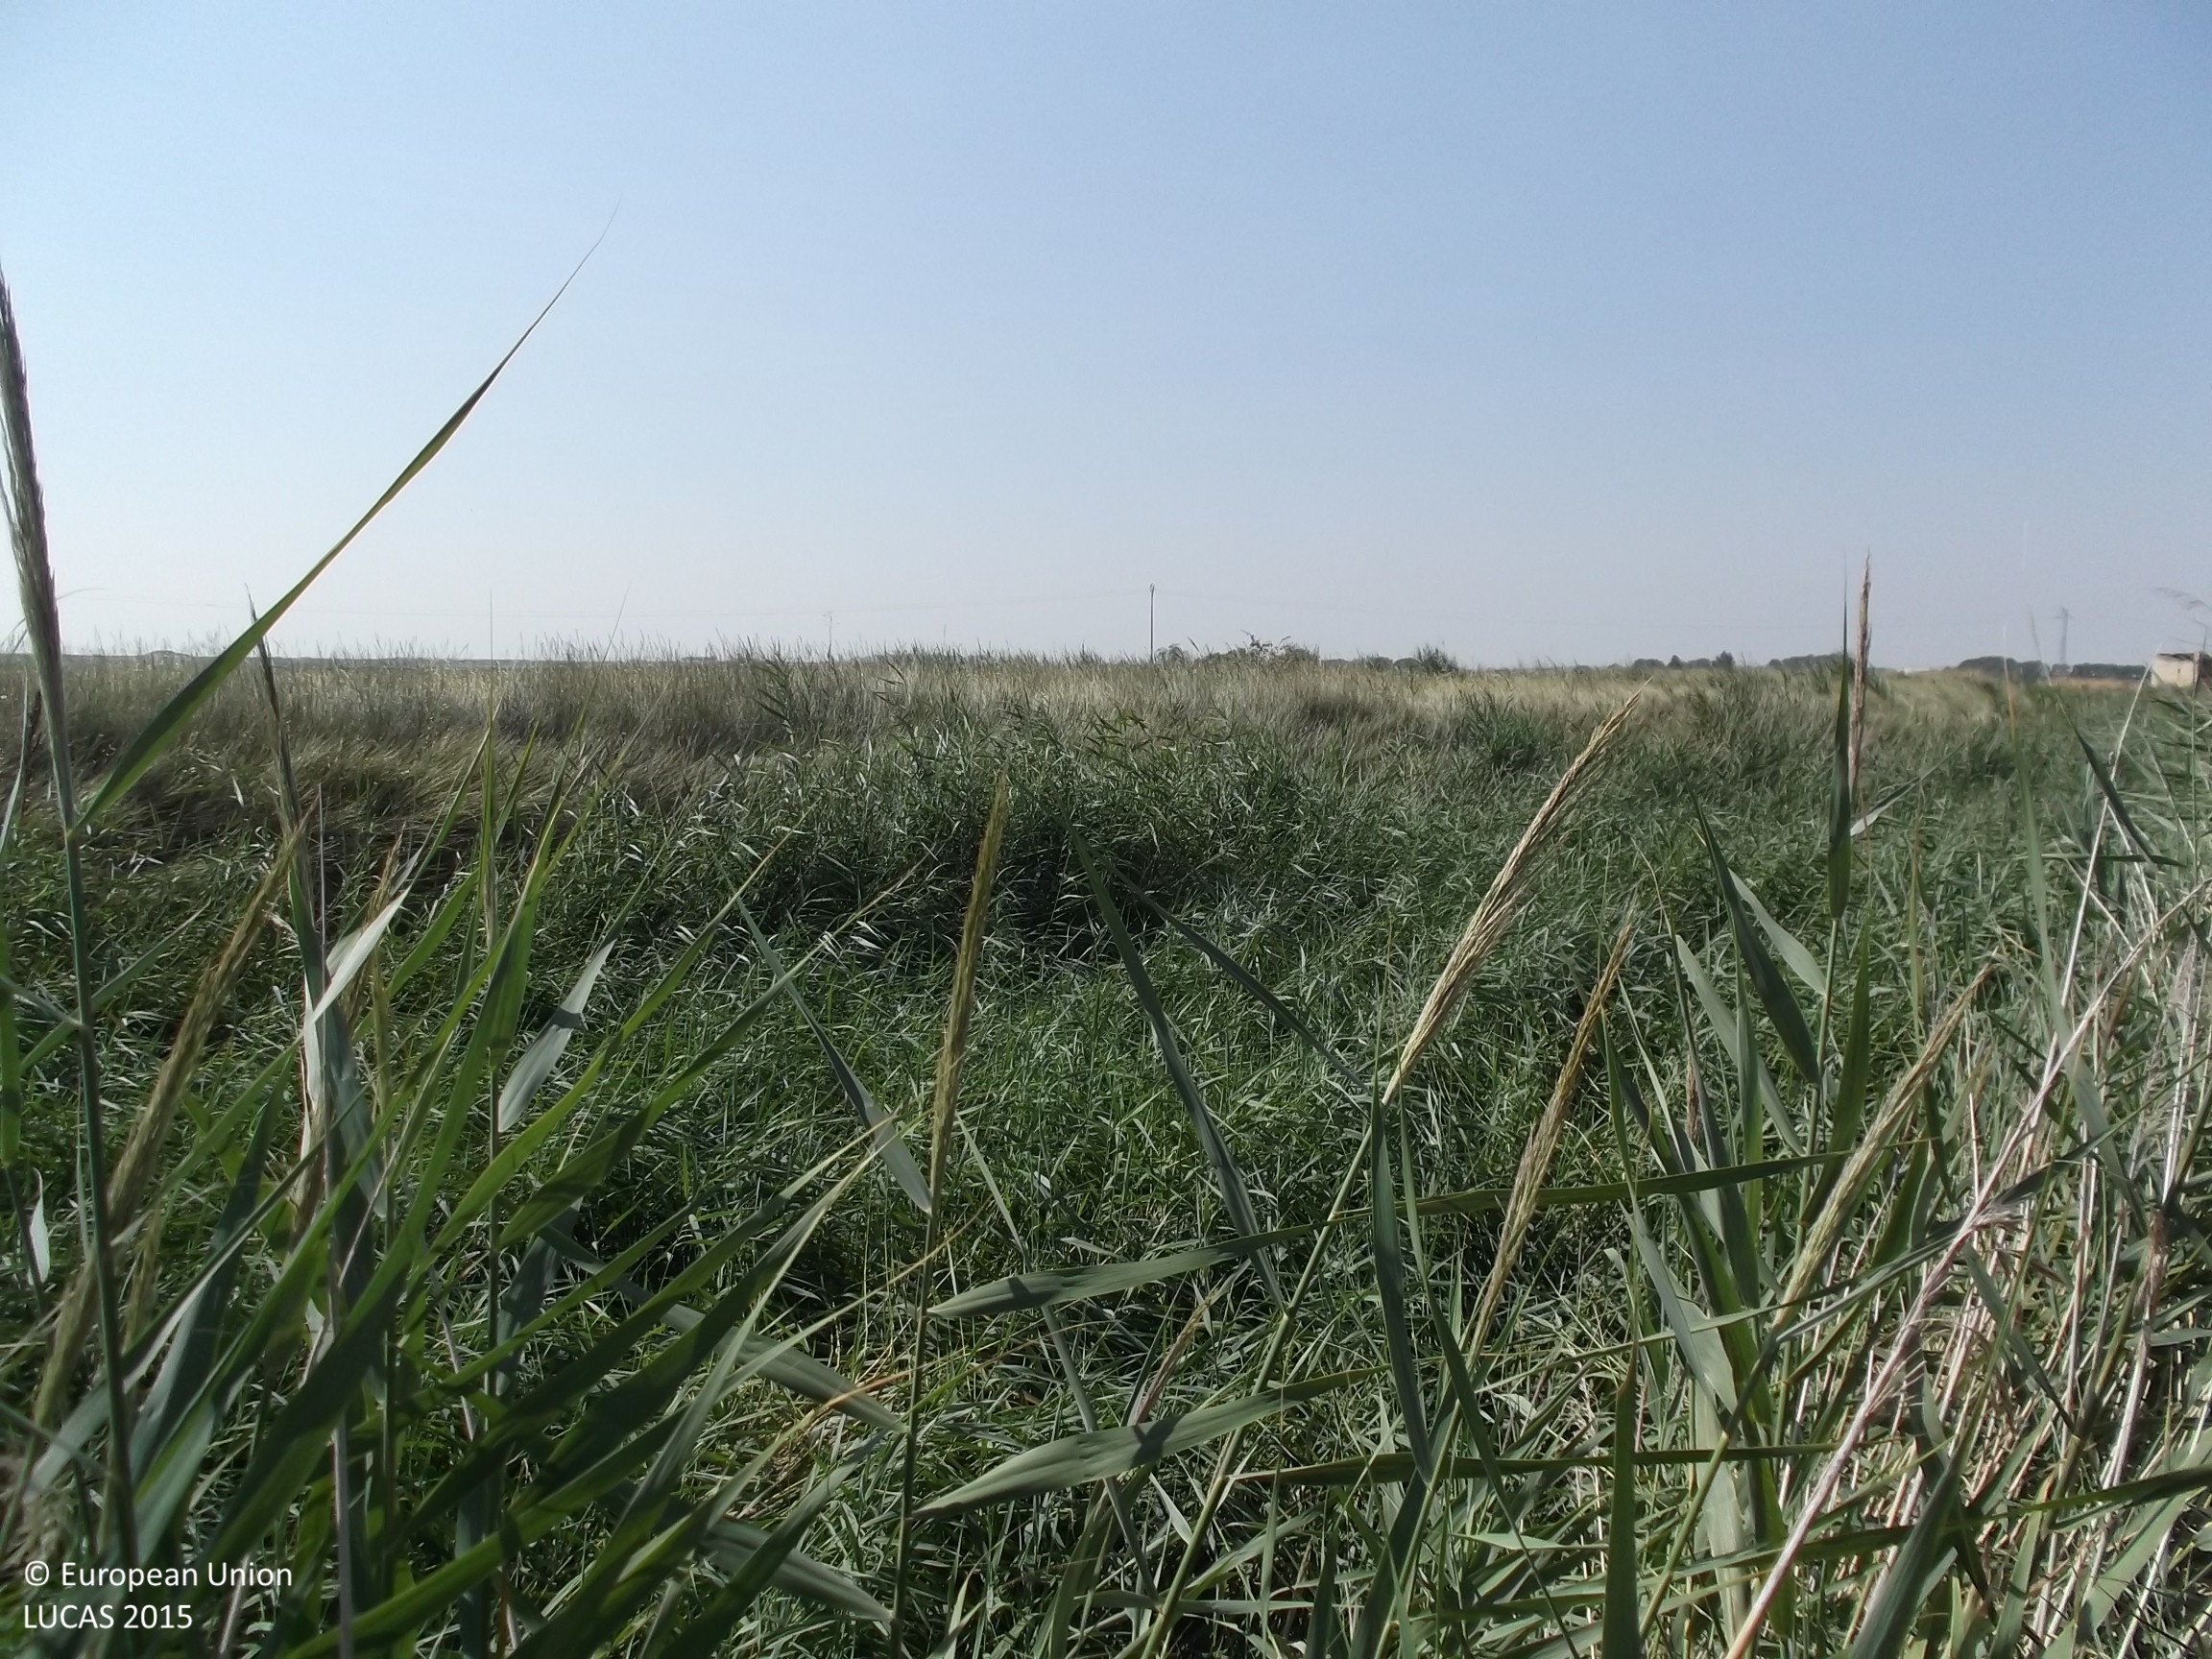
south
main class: Grassland
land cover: Grassland without tree/shrub cover
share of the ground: > 75 %
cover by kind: herbaceous plants 95 %
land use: Semi-natural and natural areas not in use
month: July
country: ES
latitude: 42.4919
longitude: -1.6312
